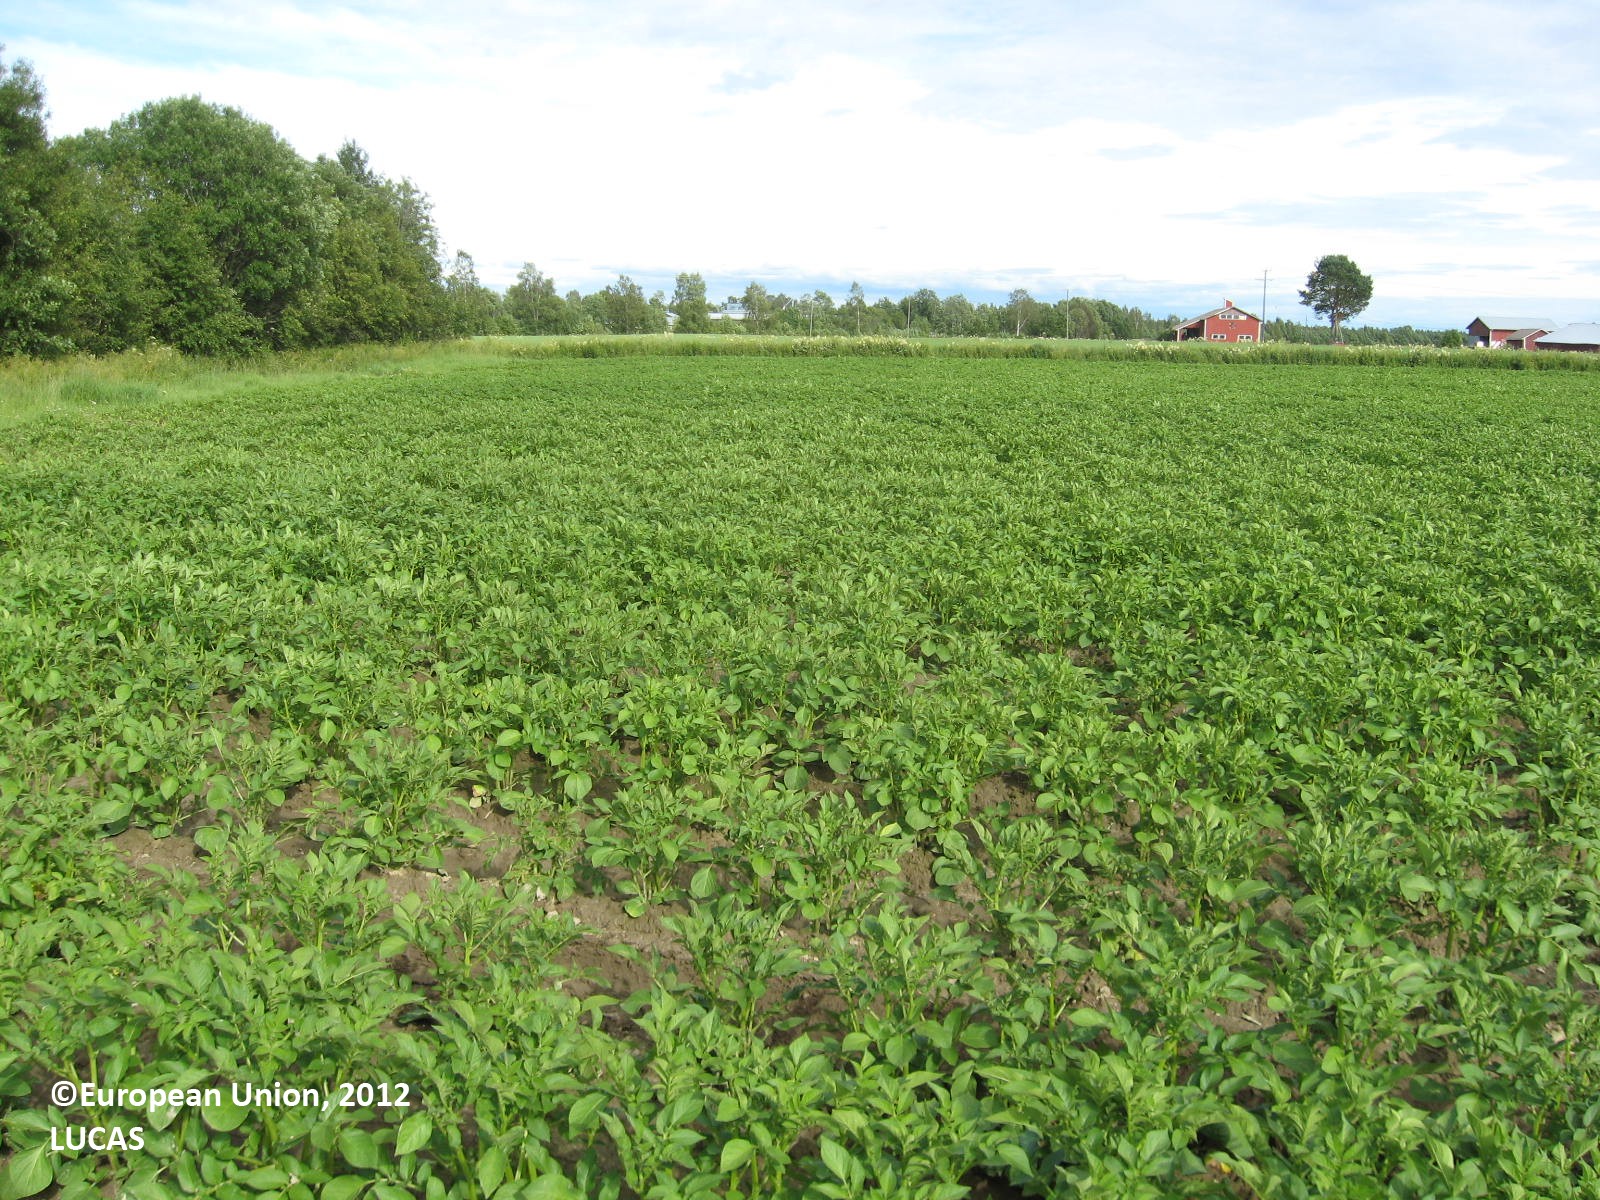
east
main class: Cropland
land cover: Potatoes
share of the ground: 50 - 75 %
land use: Agriculture (excluding fallow land and kitchen gardens)
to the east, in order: Potatoes; Shruby margins; Ditches and canals; Shruby margins; Oats; Shruby margins; Ditches and canals; Shruby margins; Oats; Electric lines; Oats
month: July
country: FI
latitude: 62.2583
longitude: 21.5420
